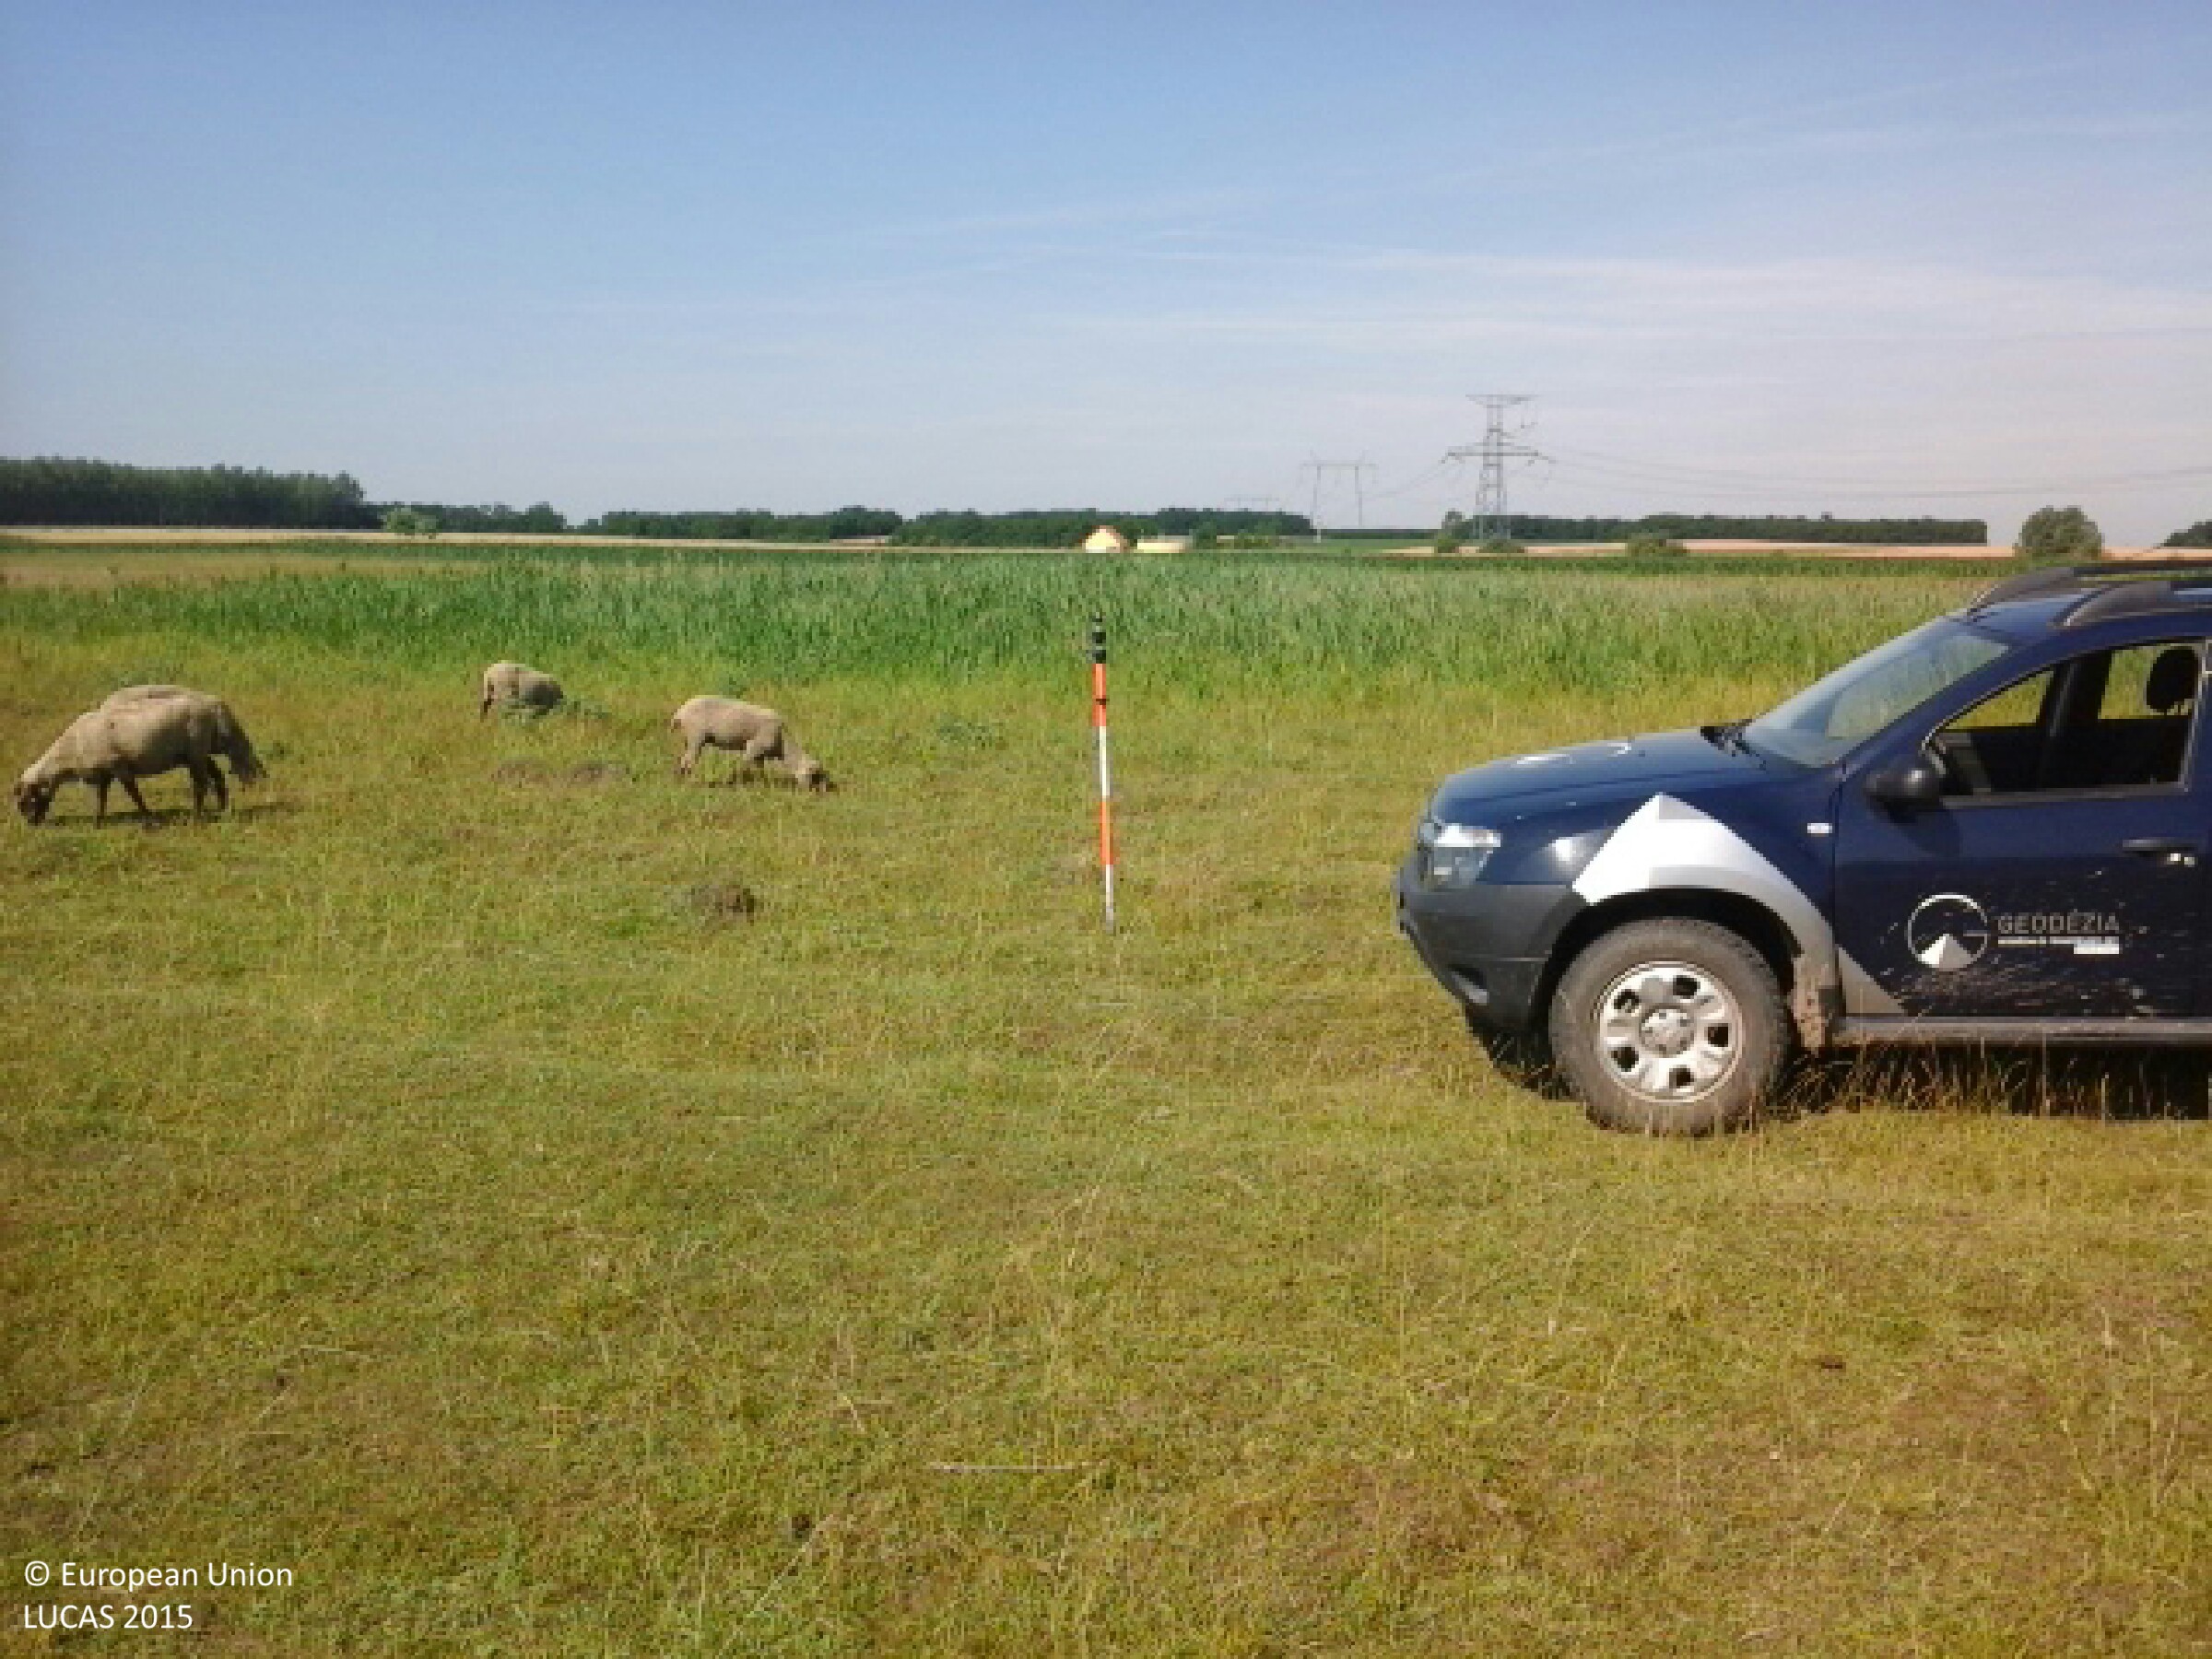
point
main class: Grassland
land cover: Grassland without tree/shrub cover
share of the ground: > 75 %
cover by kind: herbaceous plants 100 %
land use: Abandoned areas
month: June
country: HU
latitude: 47.7745
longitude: 21.7508
